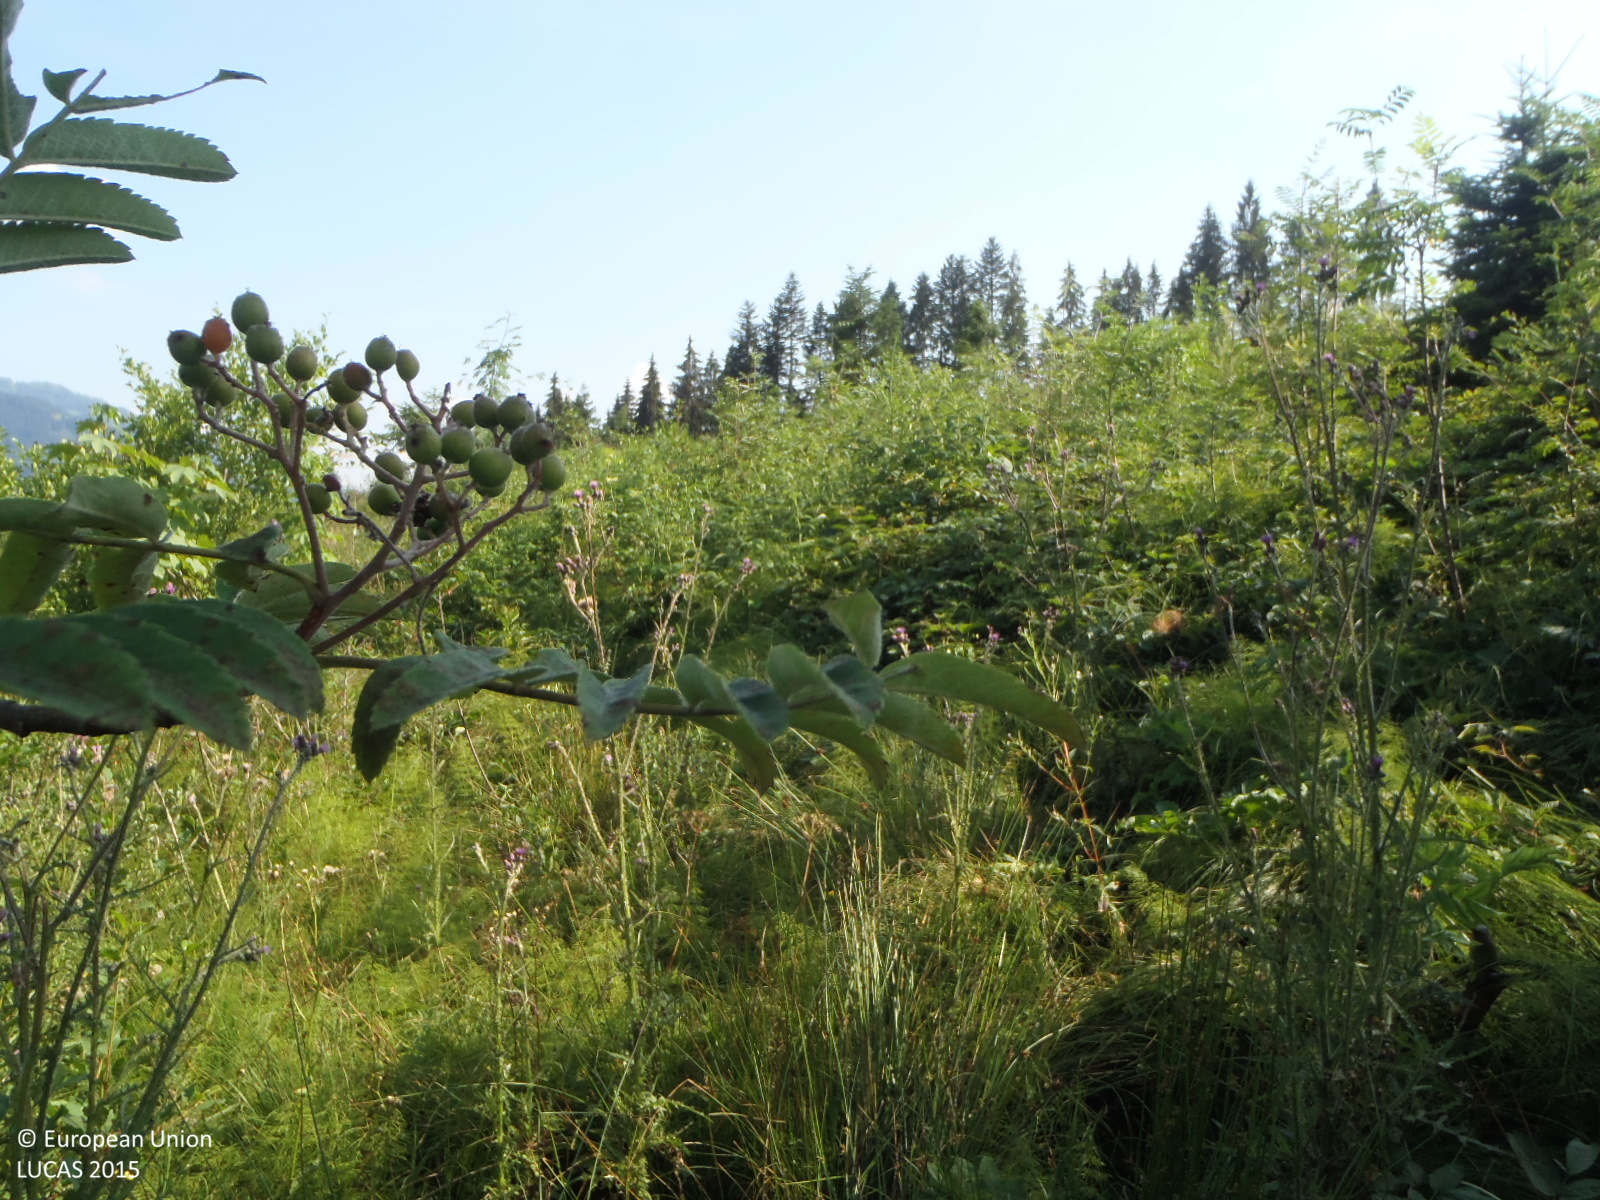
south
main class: Woodland
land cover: Spruce dominated mixed woodland
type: alpine coniferous forest
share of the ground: > 75 %
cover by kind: shrubs 45 %, herbaceous plants 25 %, coniferous forest trees 15 %, broadleaved forest trees 15 %
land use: Forestry
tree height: > 5 m
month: July
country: AT
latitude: 47.5138
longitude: 12.3752
